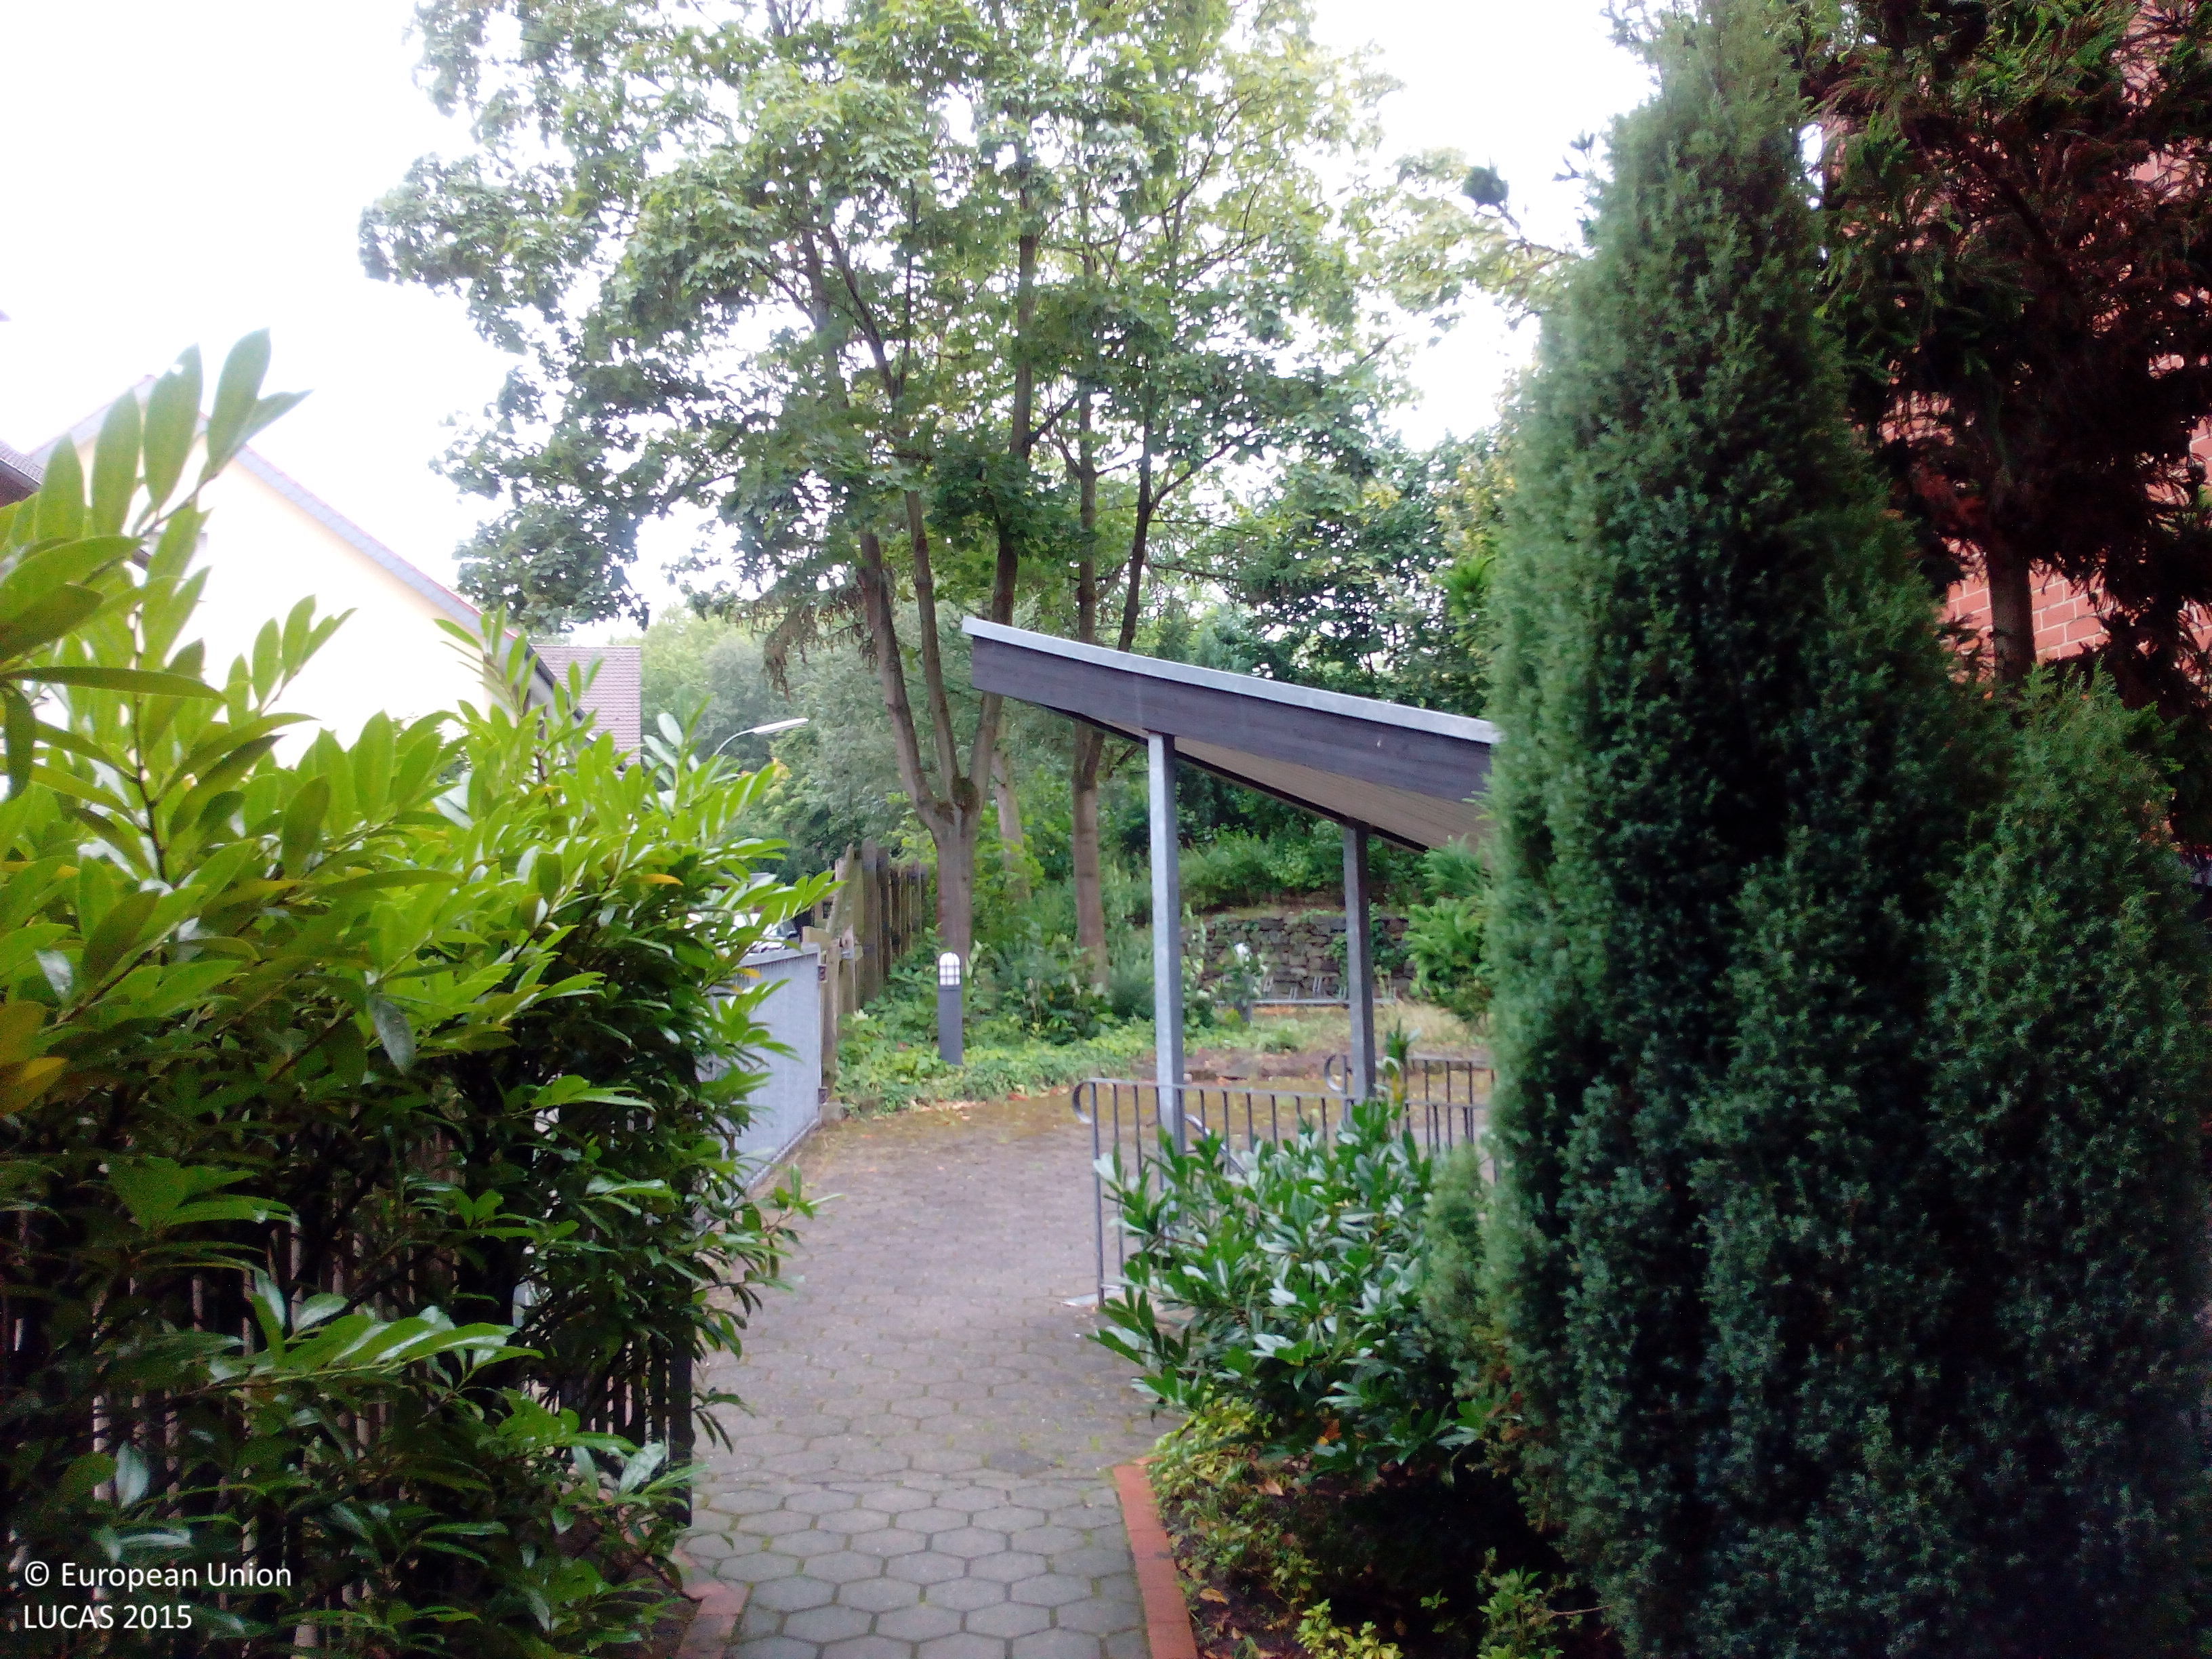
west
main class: Cropland
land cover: Floriculture and ornamental plants
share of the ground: 50 - 75 %
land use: Residential
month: July
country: DE
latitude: 52.2711
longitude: 8.0221
